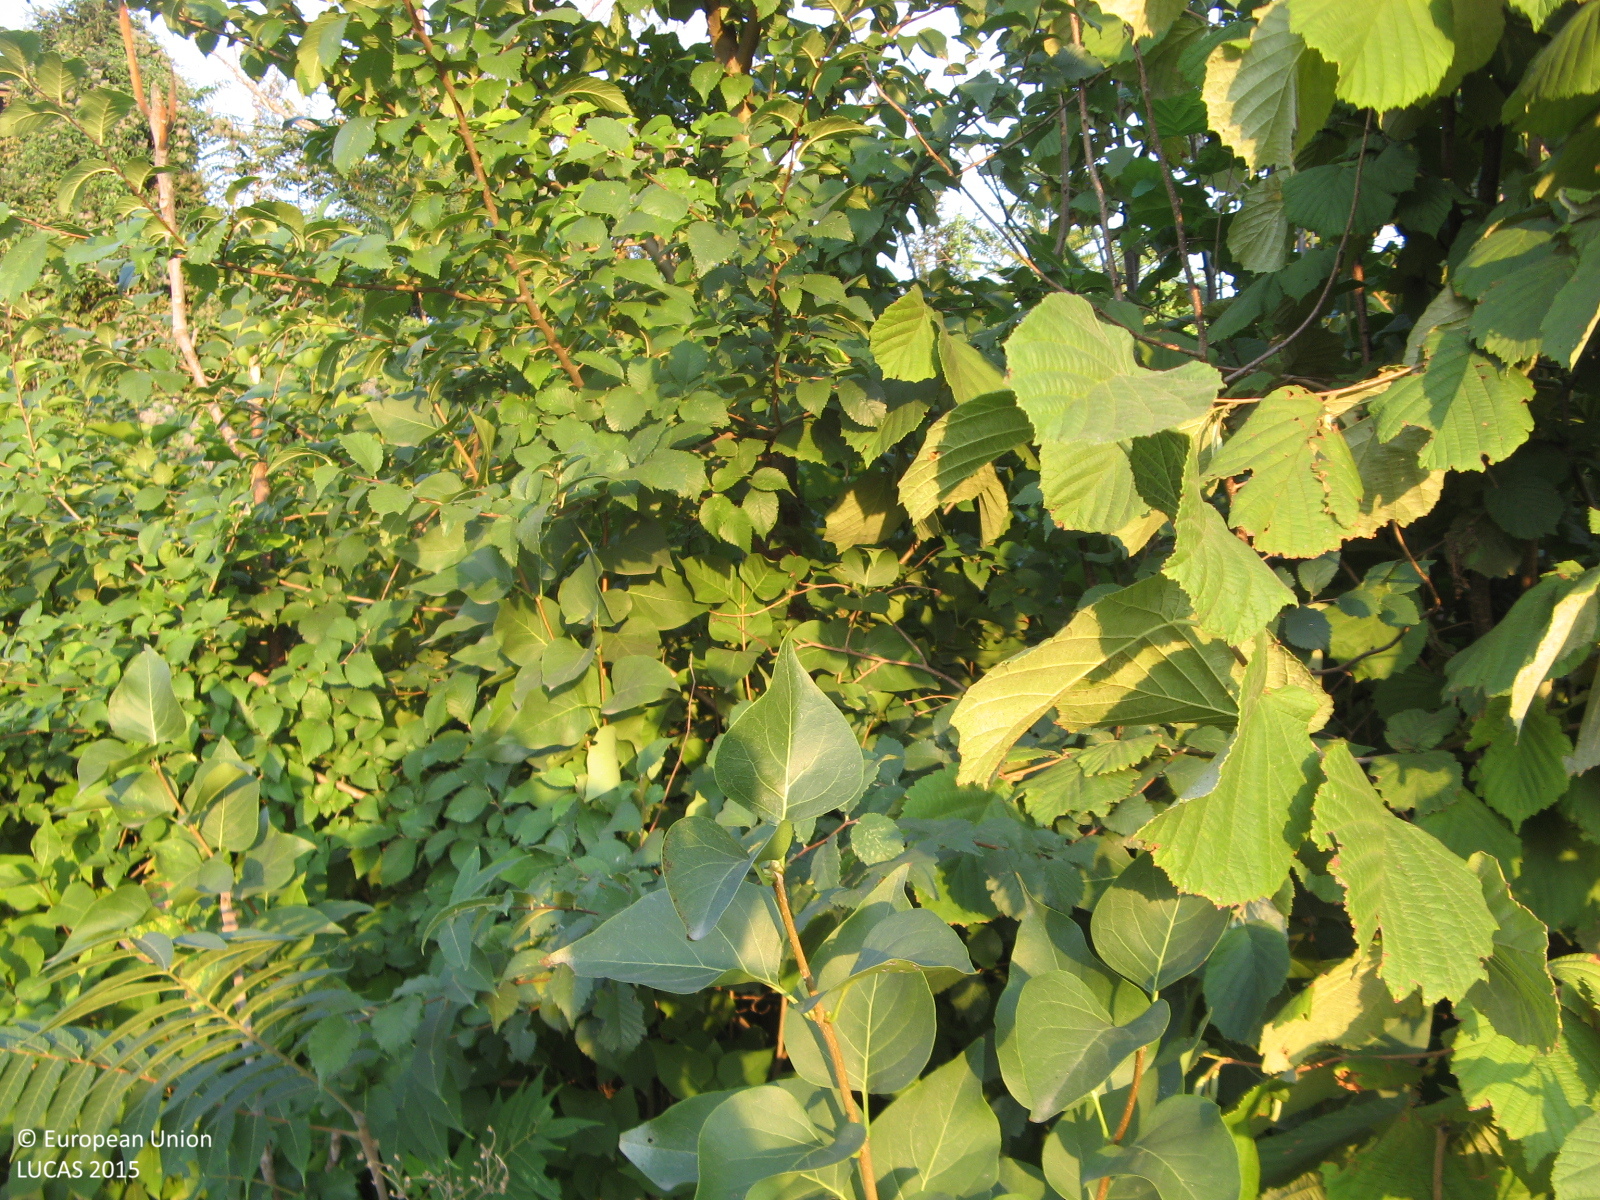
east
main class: Shrubland
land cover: Shrubland without tree cover
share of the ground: > 75 %
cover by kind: shrubs 90 %, herbaceous plants 10 %
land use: Abandoned areas
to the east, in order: Shrubland without tree cover; Artificial constructions in urban areas
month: September
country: BG
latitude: 43.8235
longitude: 25.9485
